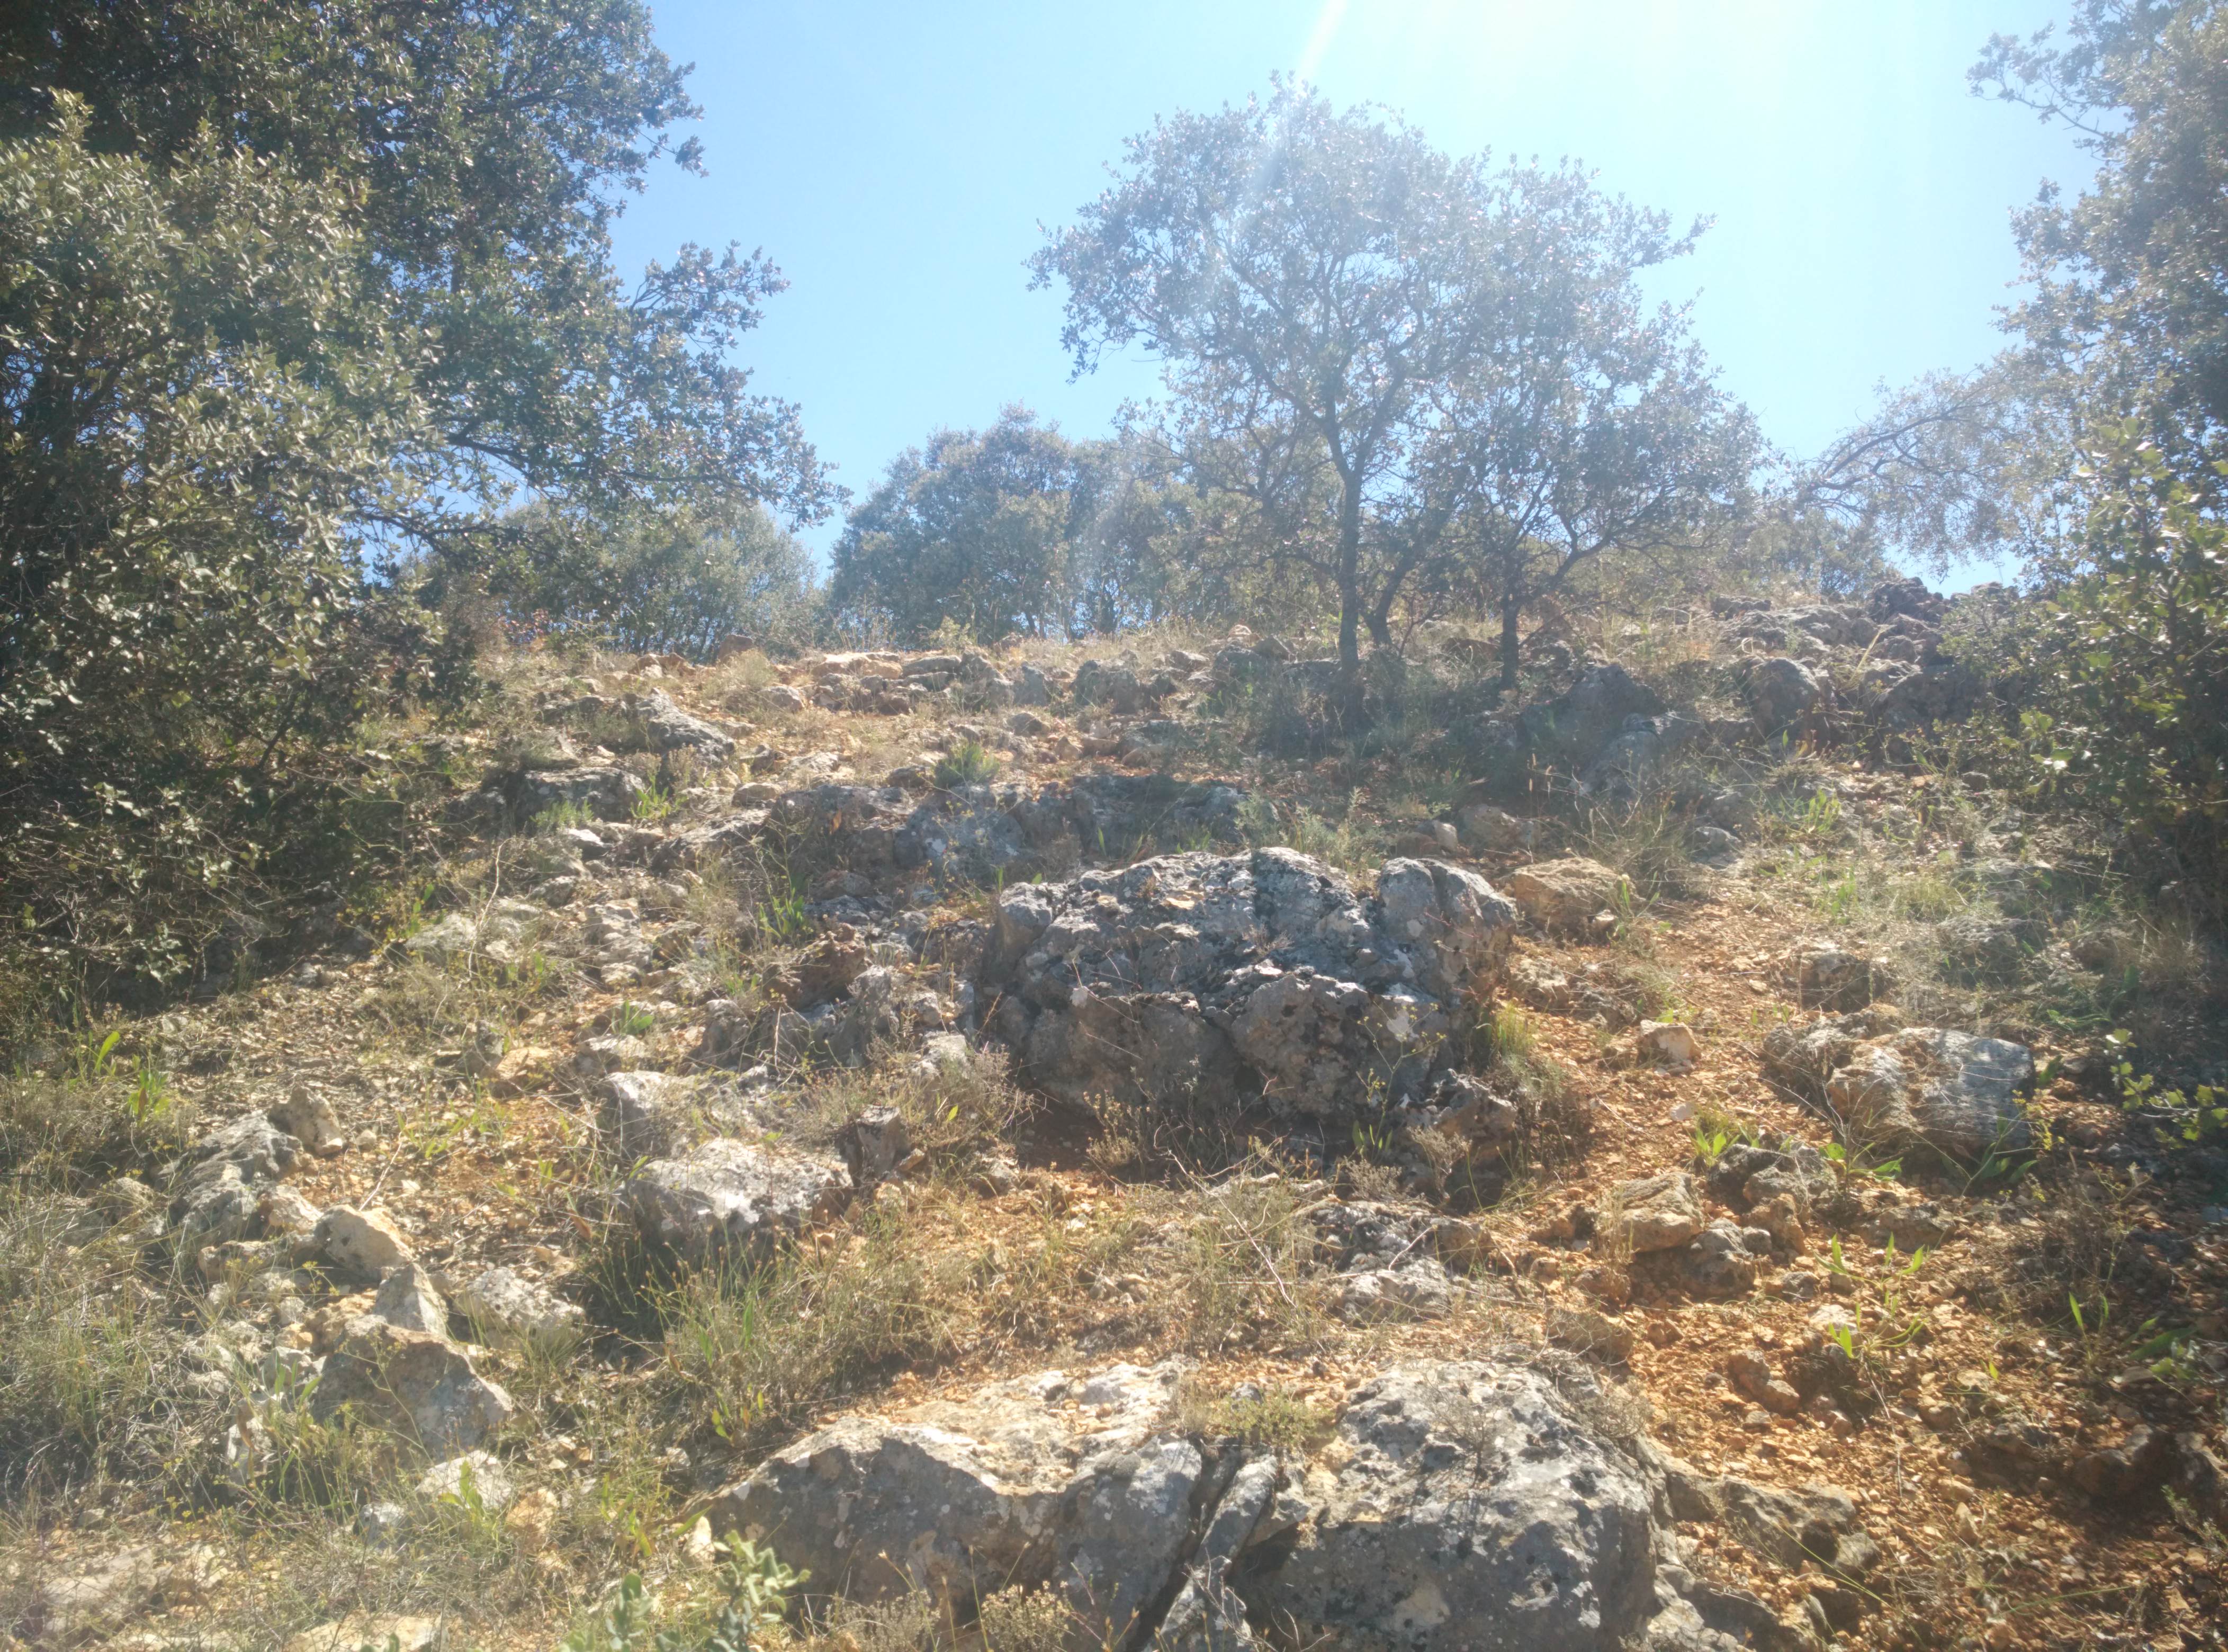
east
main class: Woodland
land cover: Broadleaved woodland
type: thermophilous deciduous forest
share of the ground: 25 - 50 %
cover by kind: broadleaved forest trees 40 %, unconsolidated bare surface 40 %, shrubs 20 %
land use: Semi-natural and natural areas not in use
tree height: > 5 m
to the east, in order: Broadleaved woodland; Tracks; Broadleaved woodland; Common wheat; Broadleaved woodland; Common wheat; Broadleaved woodland
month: July
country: ES
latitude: 40.6635
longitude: -2.8403
